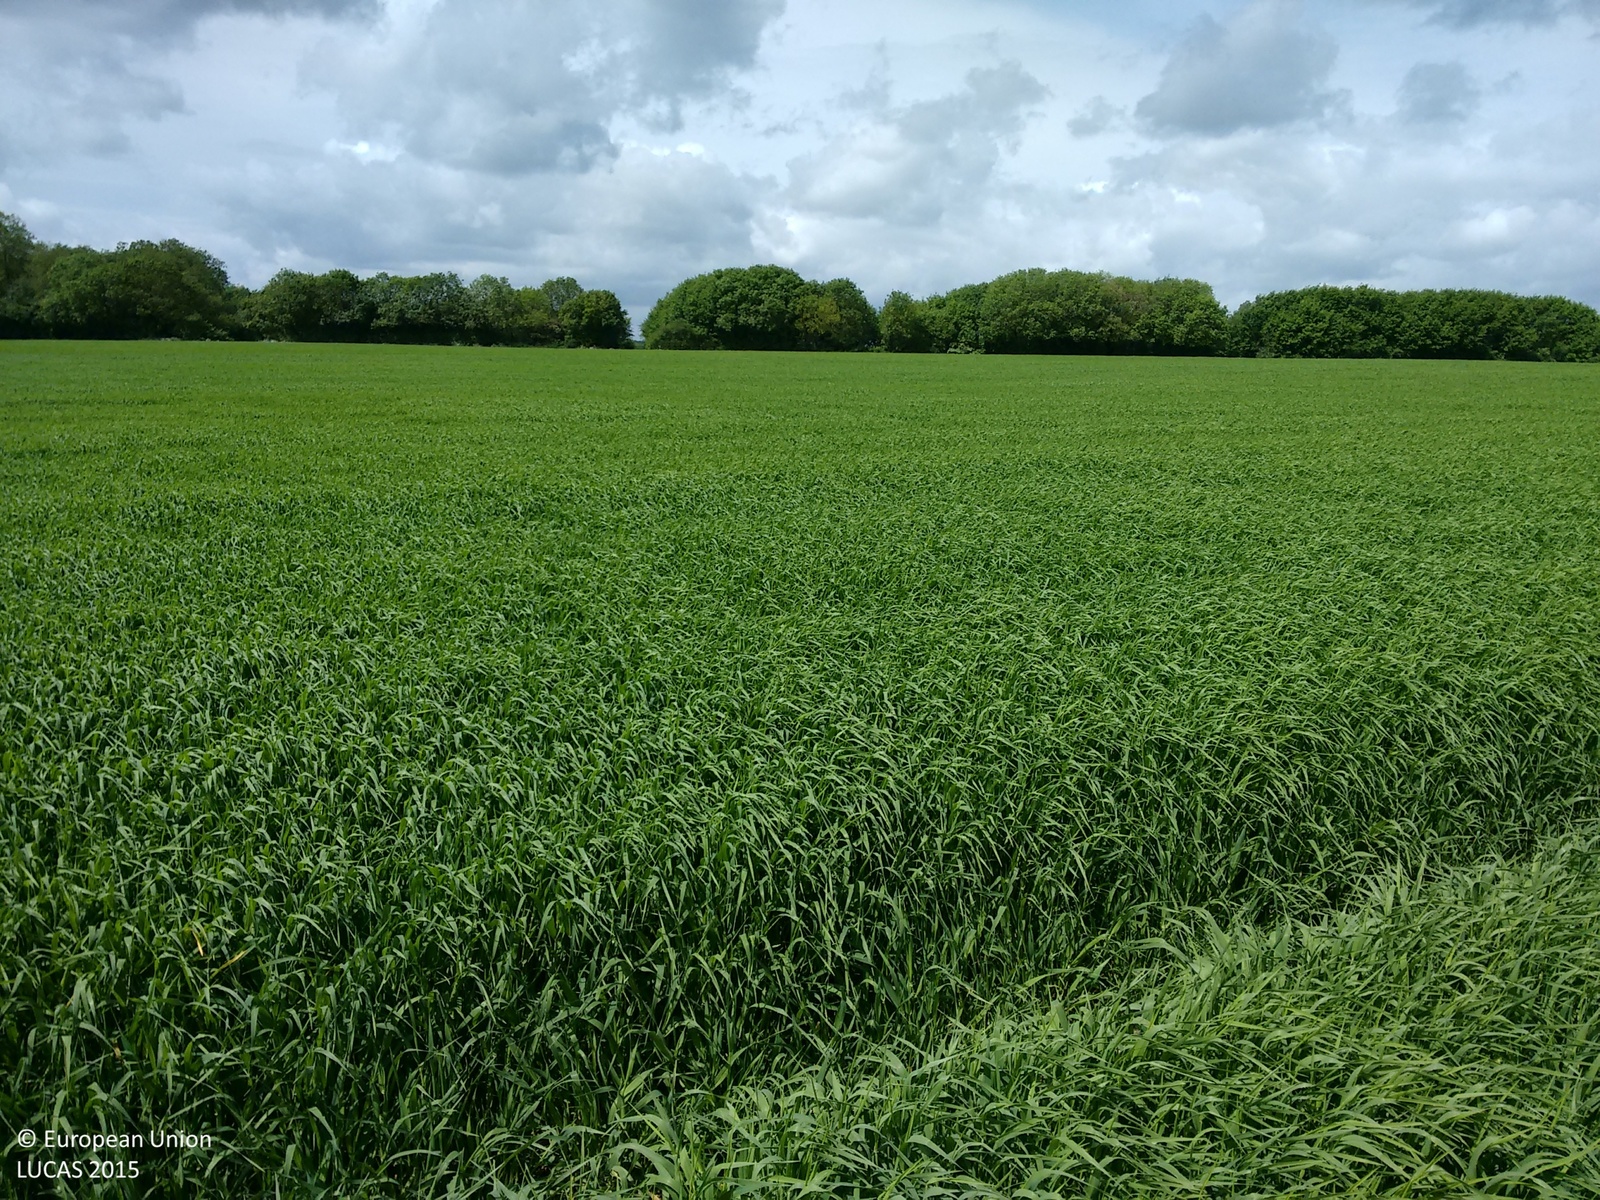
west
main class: Cropland
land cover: Barley
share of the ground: > 75 %
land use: Agriculture (excluding fallow land and kitchen gardens)
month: June
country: GB
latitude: 52.2338
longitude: -0.3298
